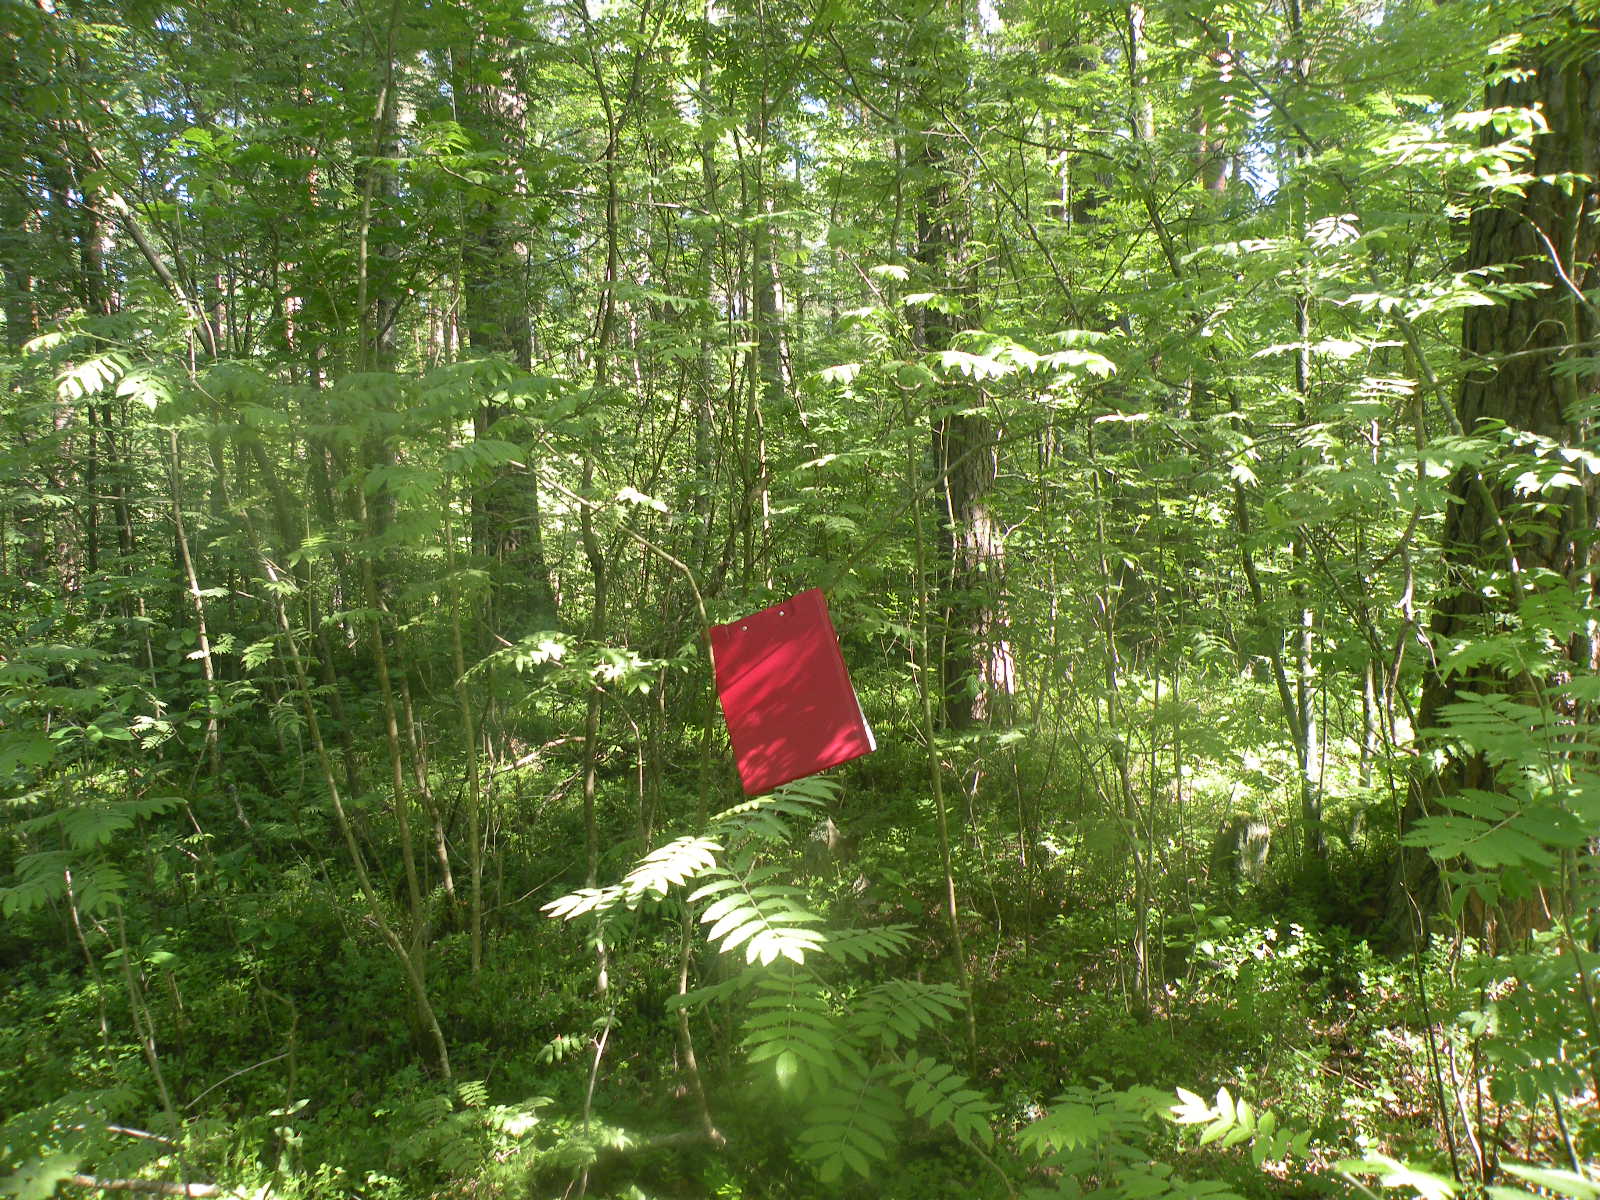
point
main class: Woodland
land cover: Pine dominated mixed woodland
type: hemiboreal forest and nemoral coniferous forest and mixed broadleaved-coniferous forest
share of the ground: > 75 %
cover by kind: coniferous forest trees 55 %, broadleaved forest trees 25 %, shrubs 10 %, herbaceous plants 10 %
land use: Forestry
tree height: > 5 m
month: June
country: LV
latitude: 55.8857
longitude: 26.6049
